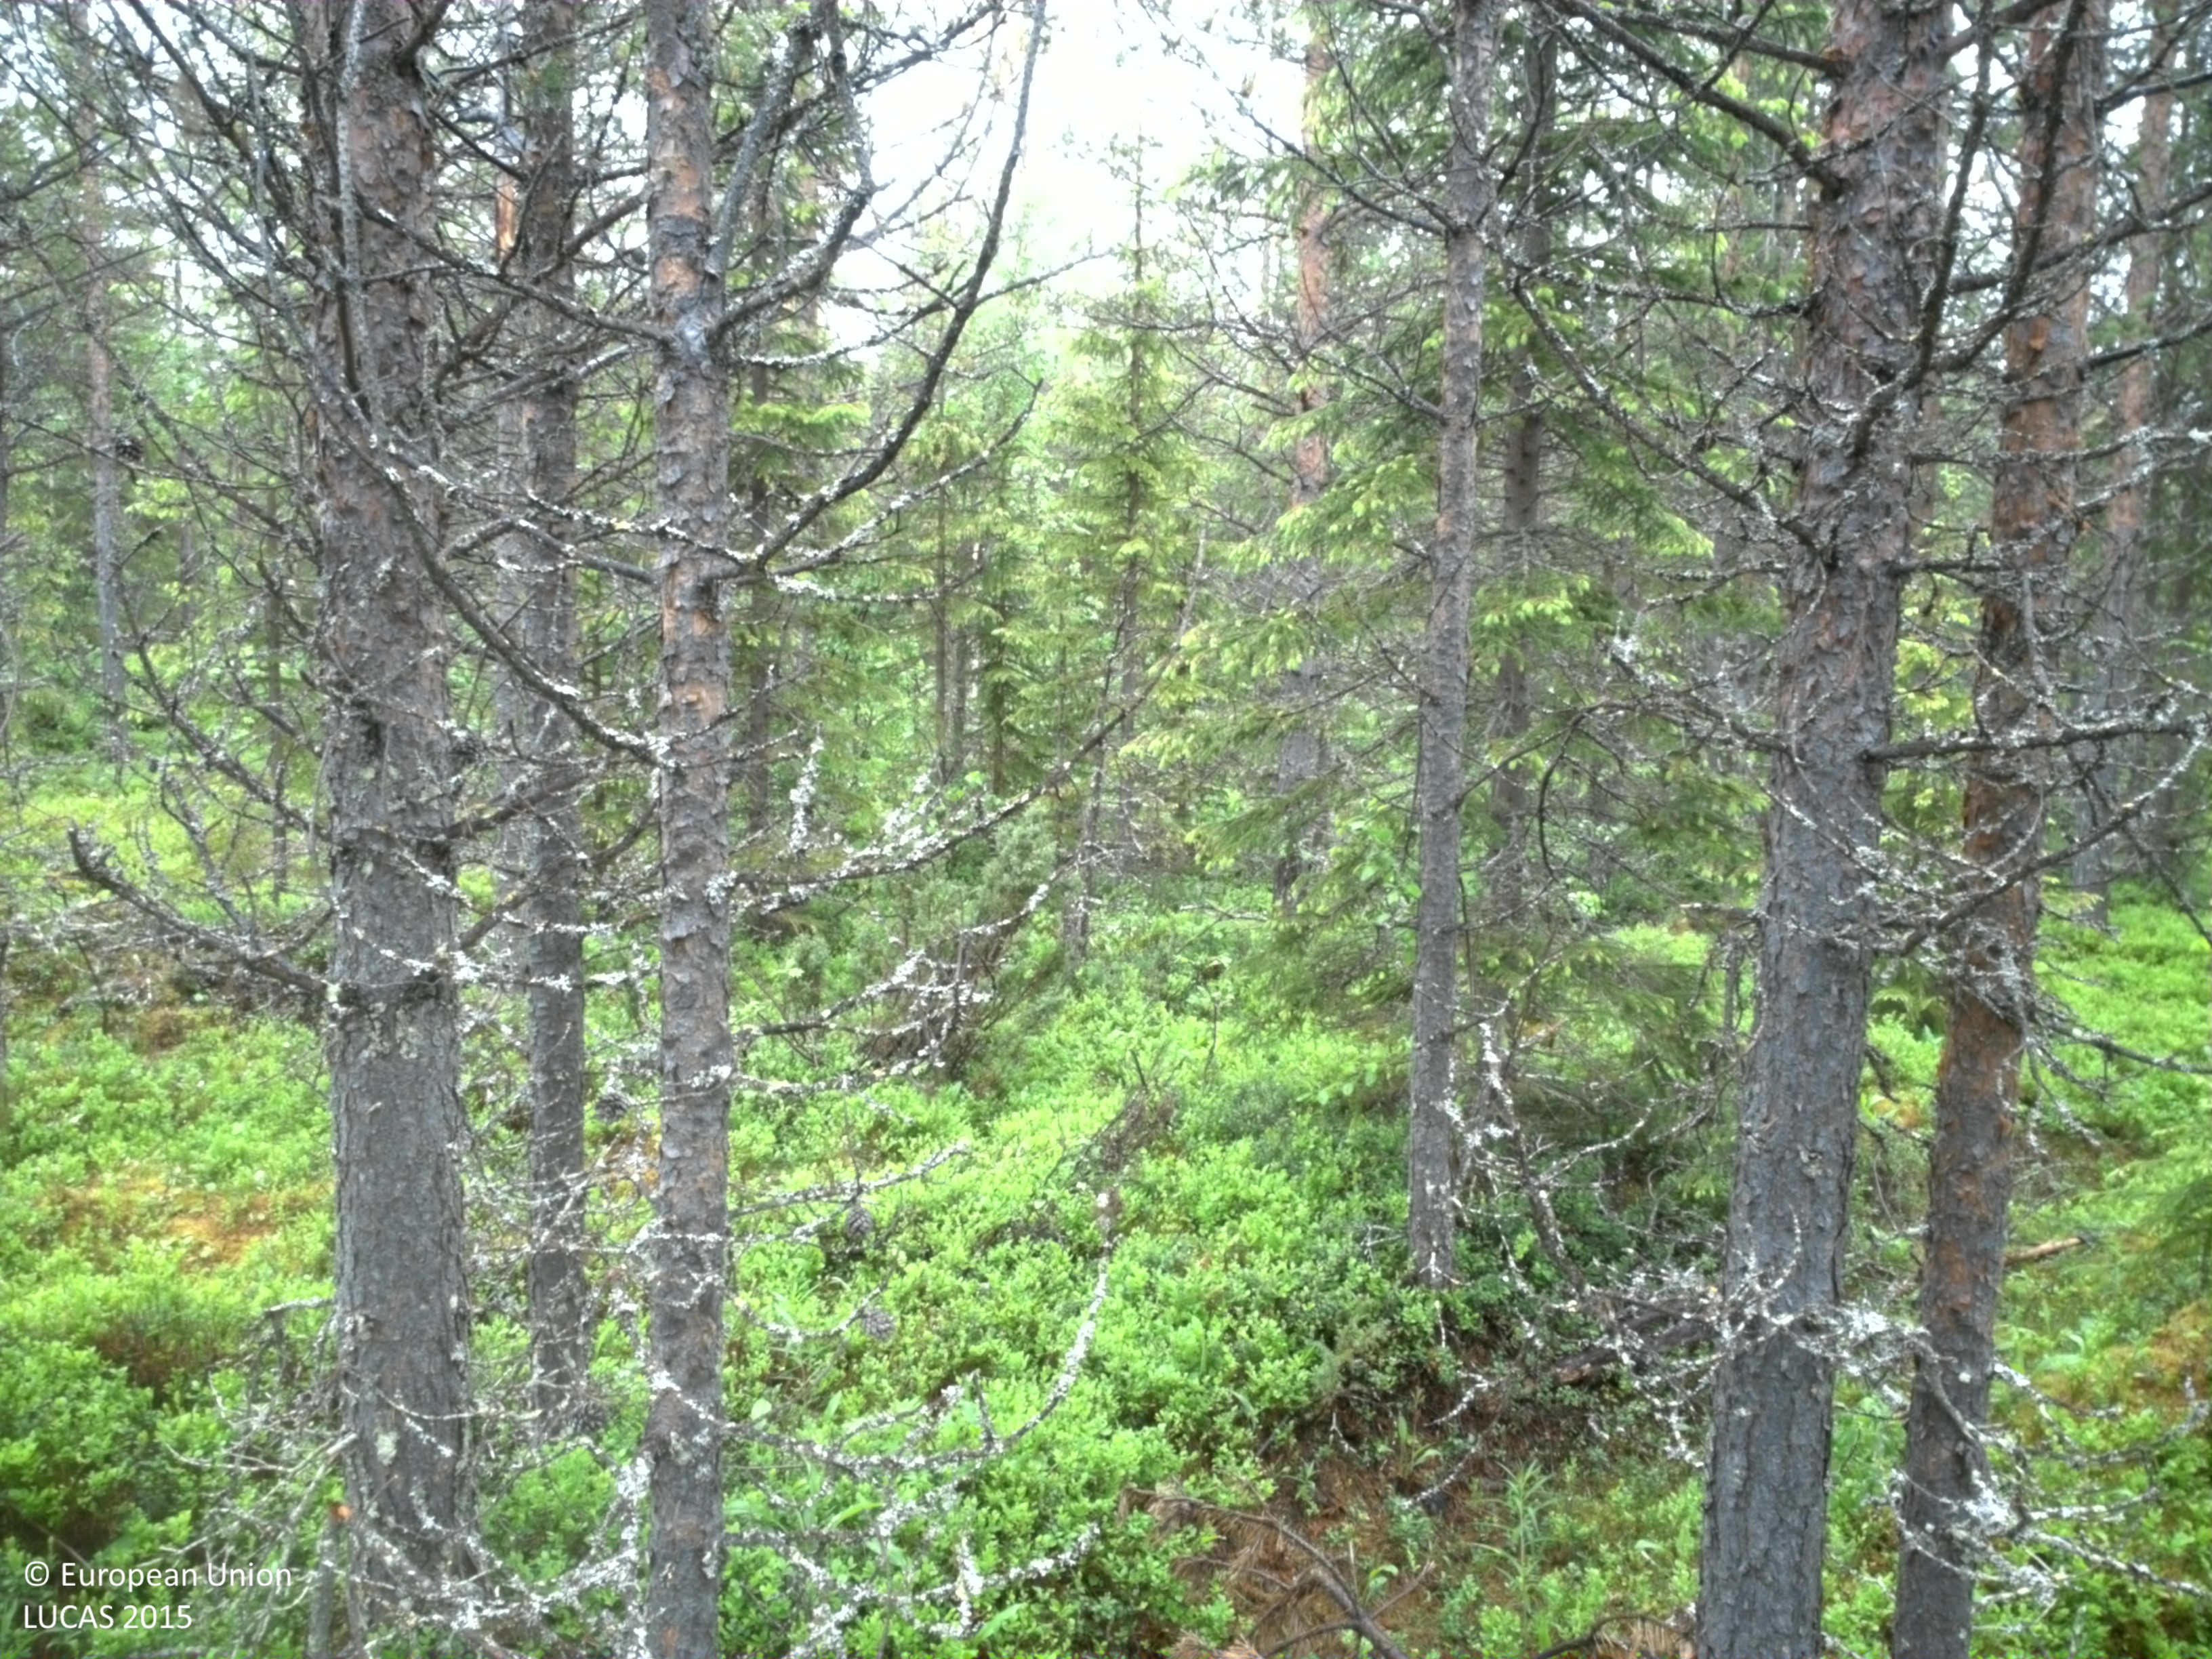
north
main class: Woodland
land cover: Pine dominated coniferous woodland
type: boreal forest
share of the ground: 25 - 50 %
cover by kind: shrubs 55 %, coniferous forest trees 40 %, broadleaved forest trees 5 %
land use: Forestry
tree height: > 5 m
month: June
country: SE
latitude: 66.5566
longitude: 22.8365
